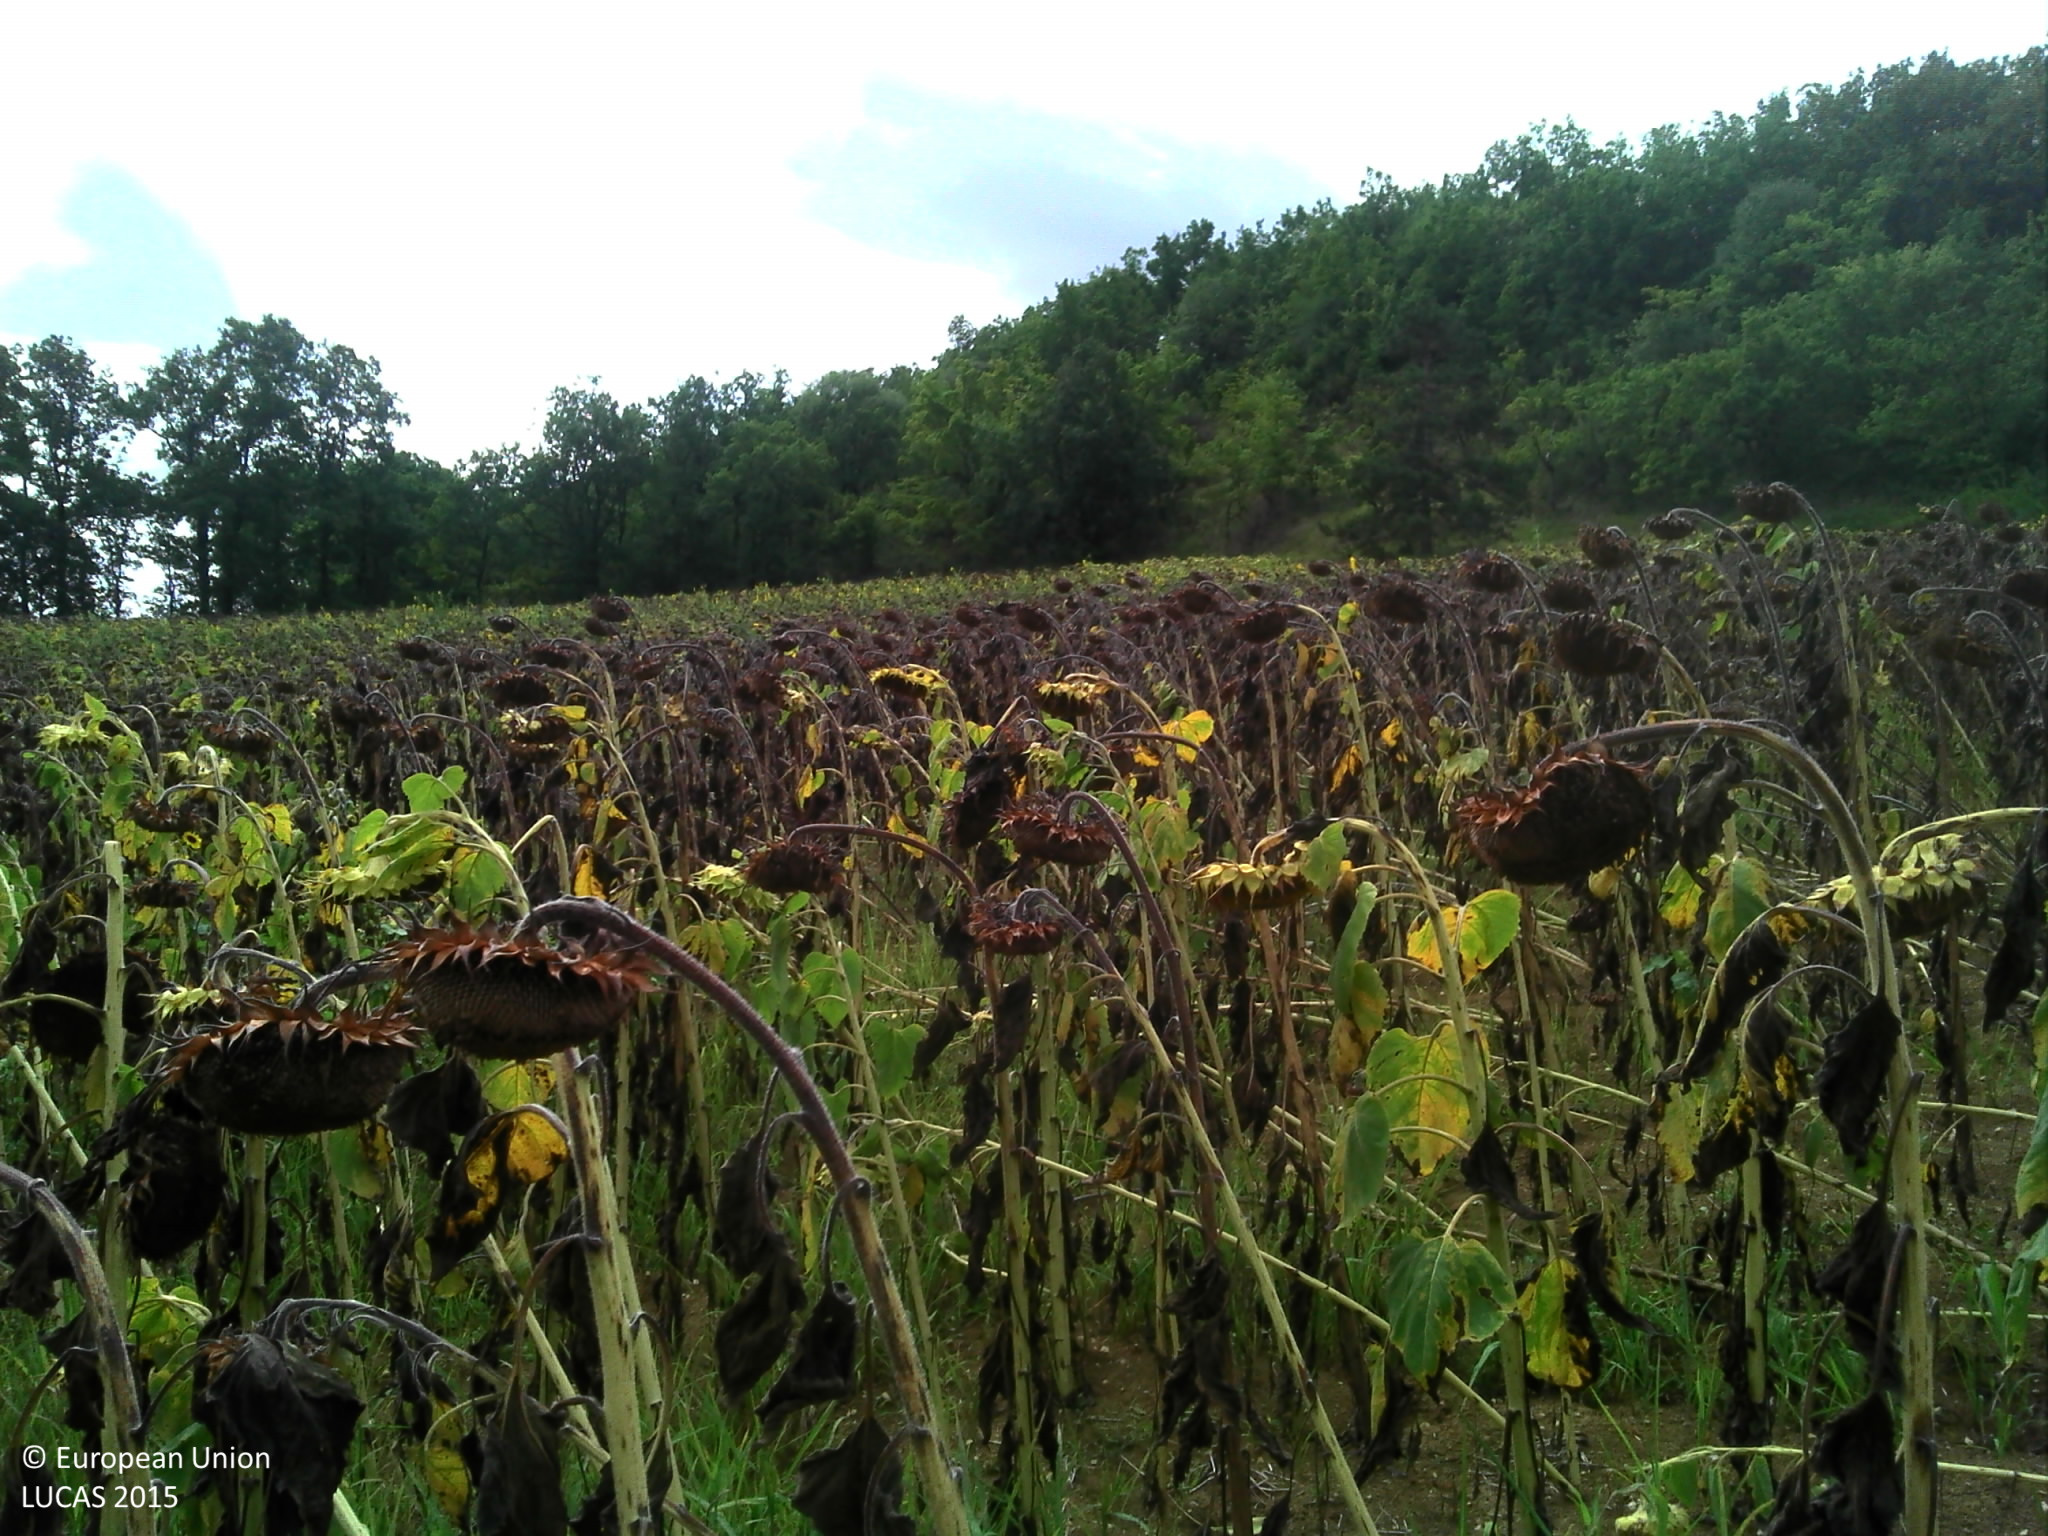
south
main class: Cropland
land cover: Sunflower
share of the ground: > 75 %
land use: Agriculture (excluding fallow land and kitchen gardens)
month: August
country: FR
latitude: 44.3118
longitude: 1.3102
